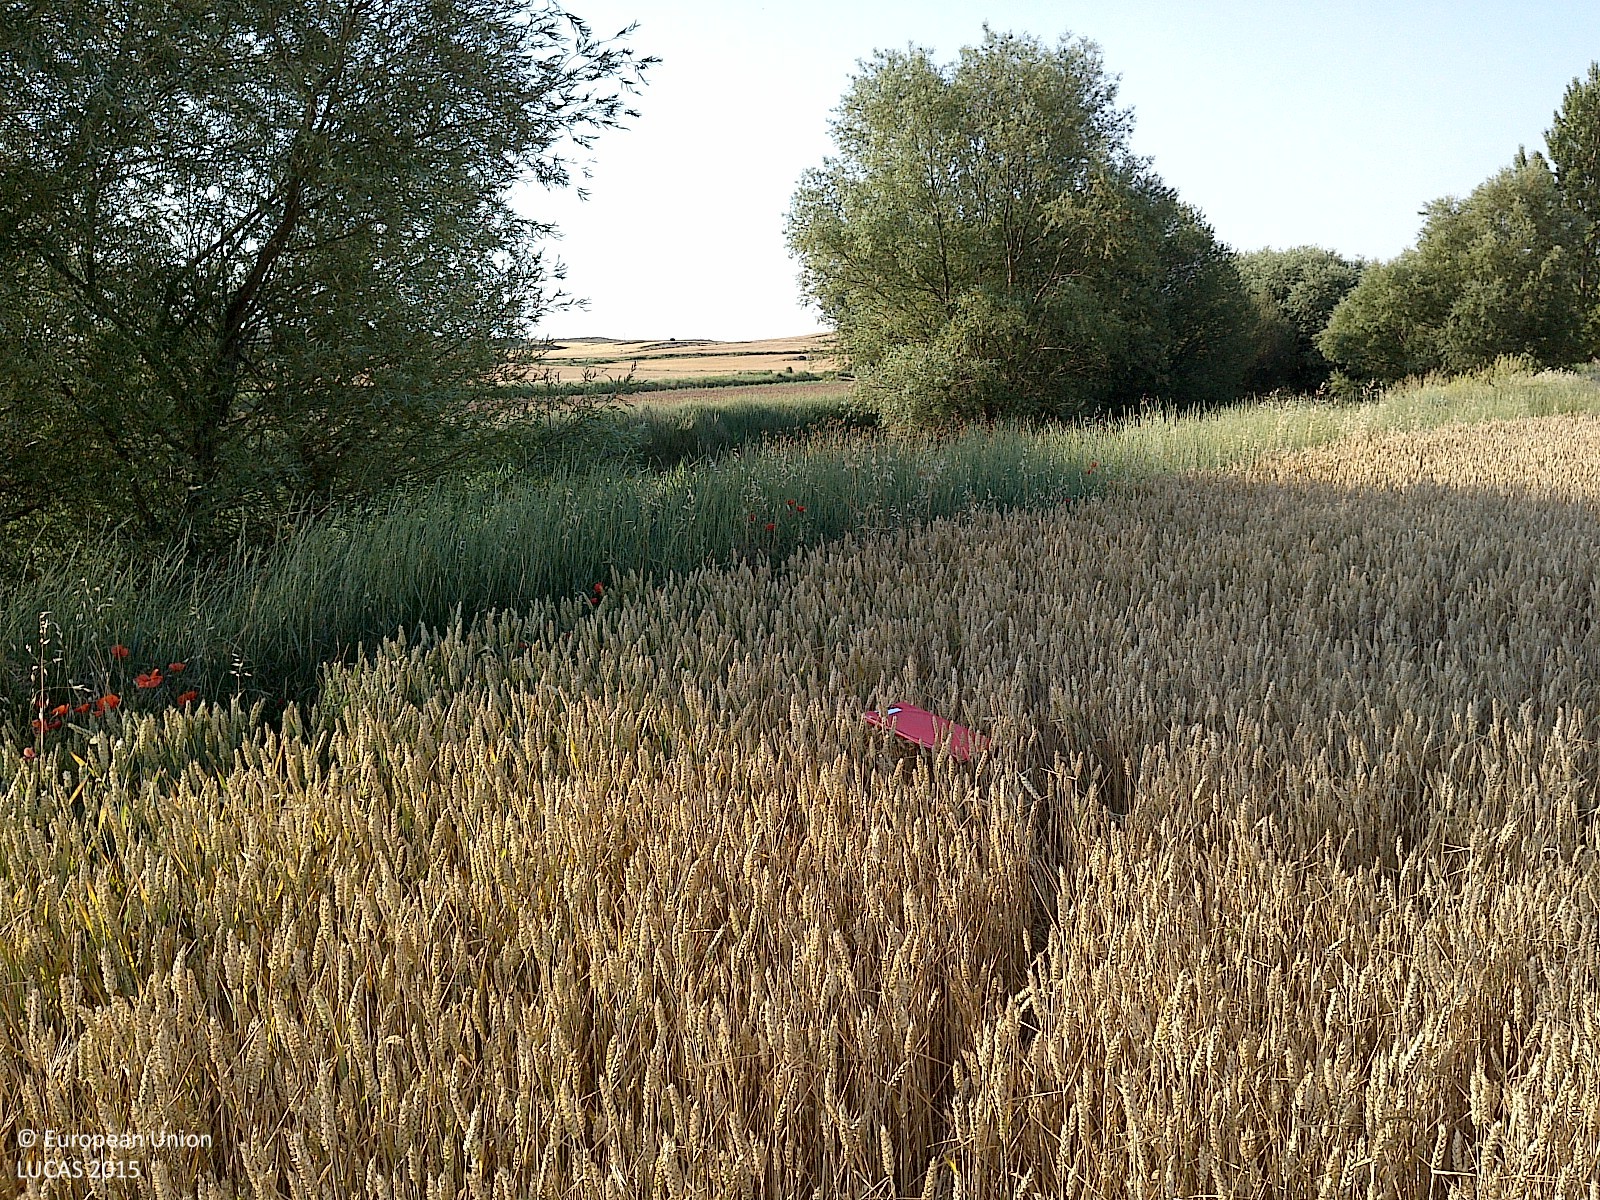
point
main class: Cropland
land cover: Common wheat
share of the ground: > 75 %
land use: Agriculture (excluding fallow land and kitchen gardens)
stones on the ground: < 10 %
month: June
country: ES
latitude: 41.6495
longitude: -2.2698
